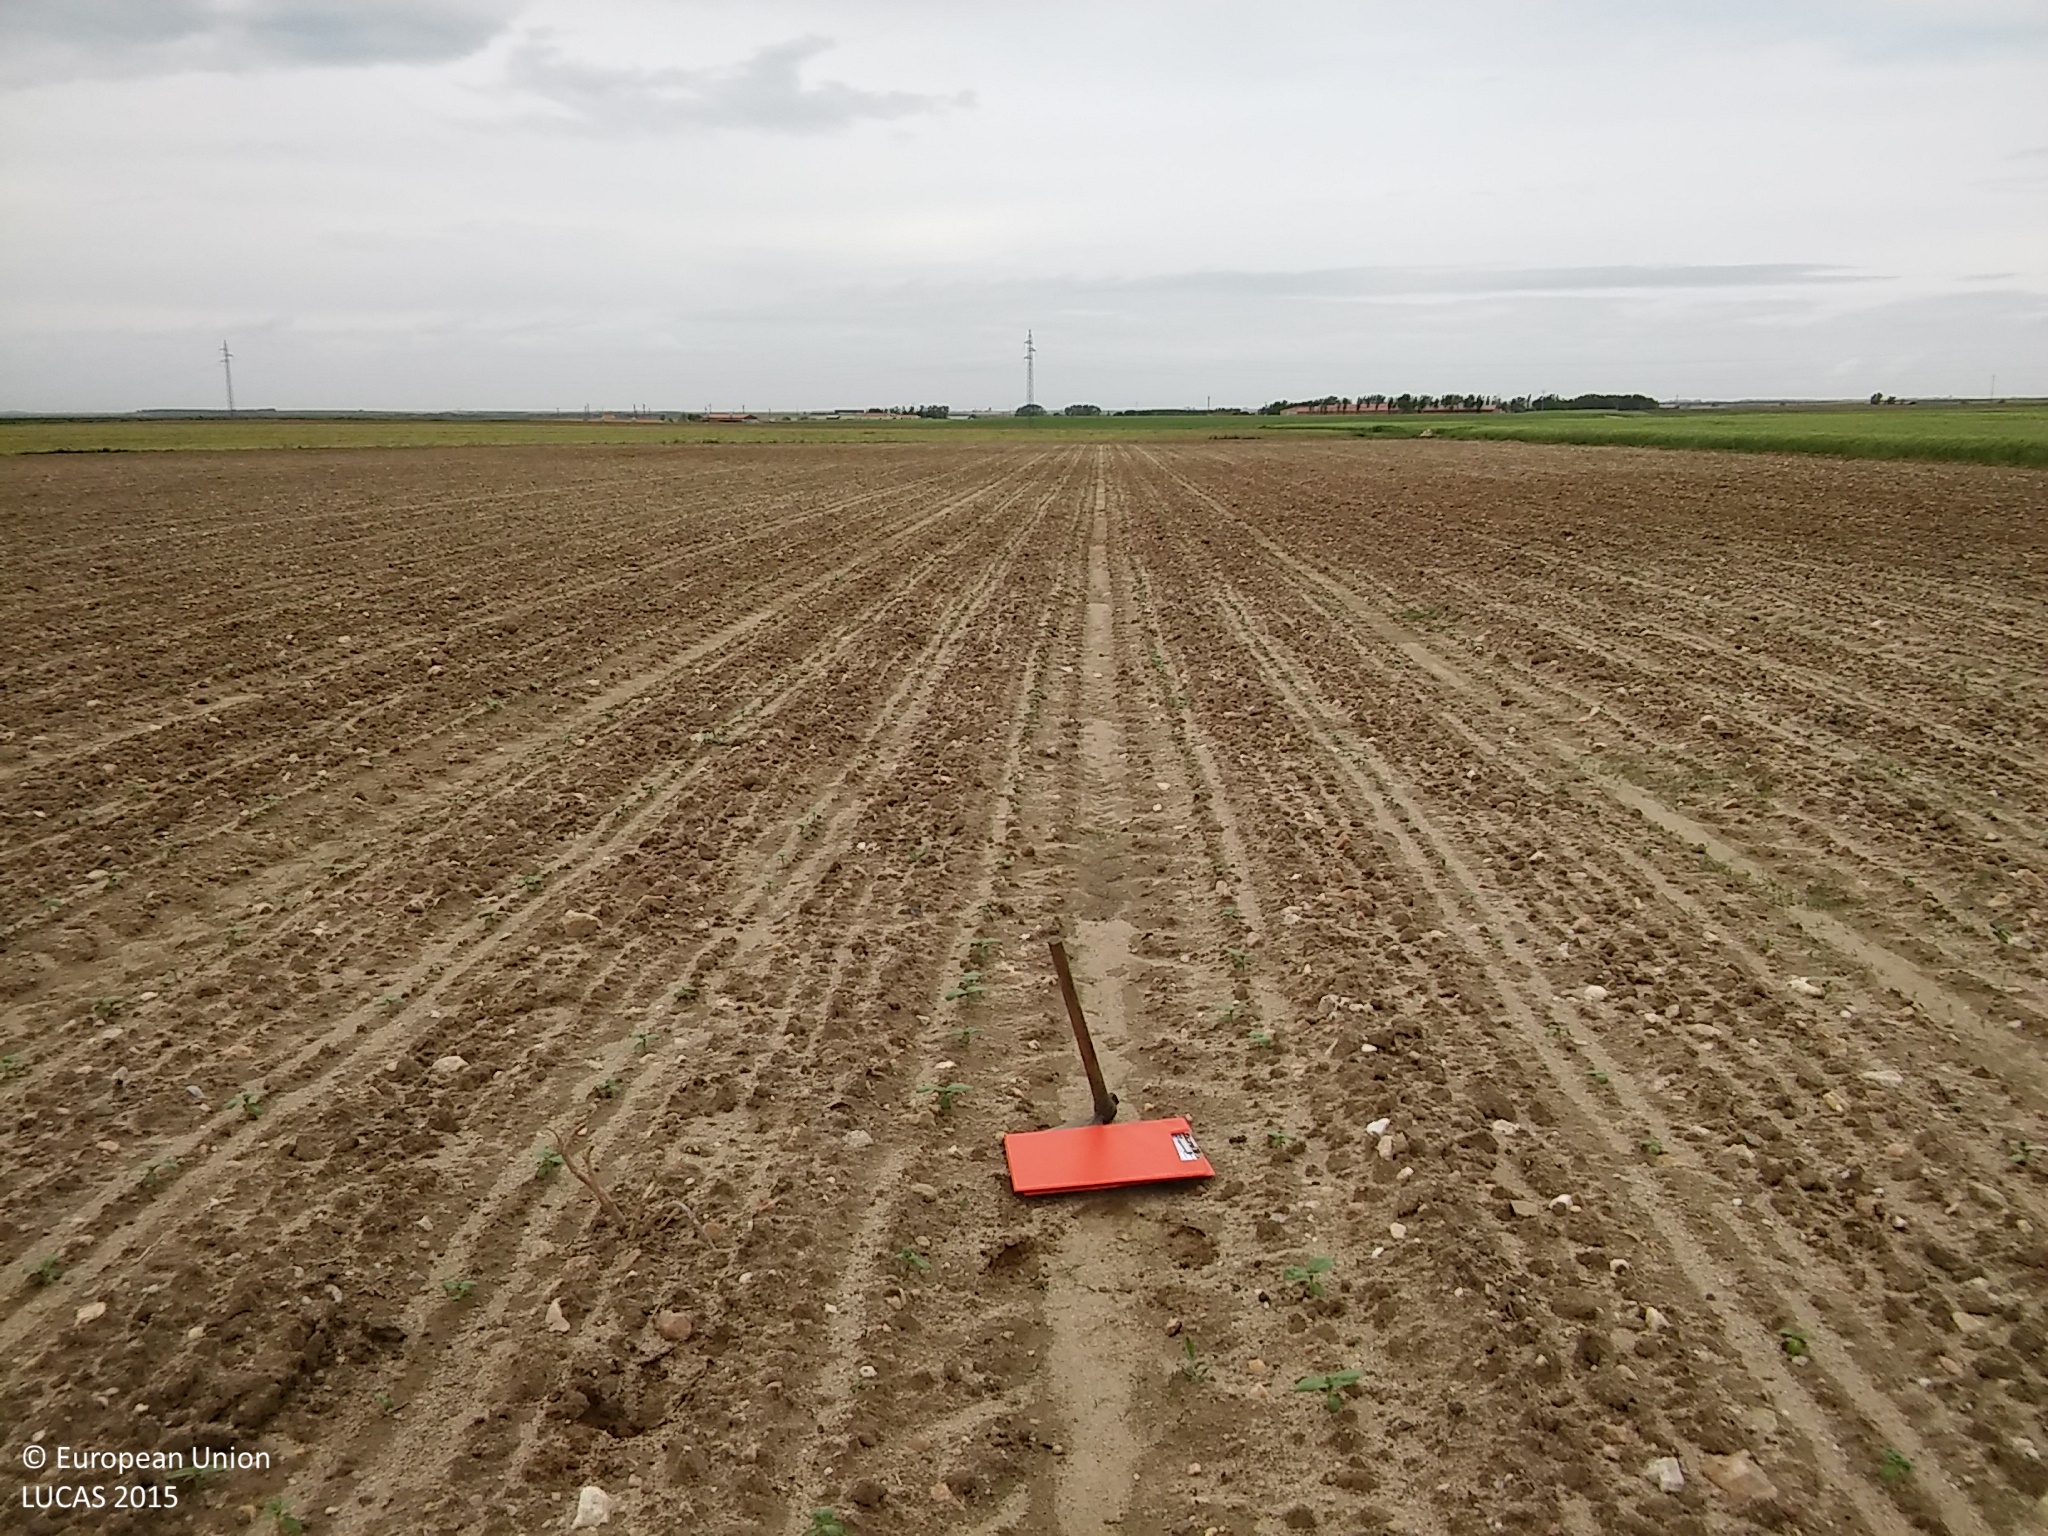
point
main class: Cropland
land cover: Sunflower
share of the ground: < 10 %
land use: Agriculture (excluding fallow land and kitchen gardens)
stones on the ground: 25 - 50 %
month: May
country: ES
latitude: 41.1493
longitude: -4.1008
